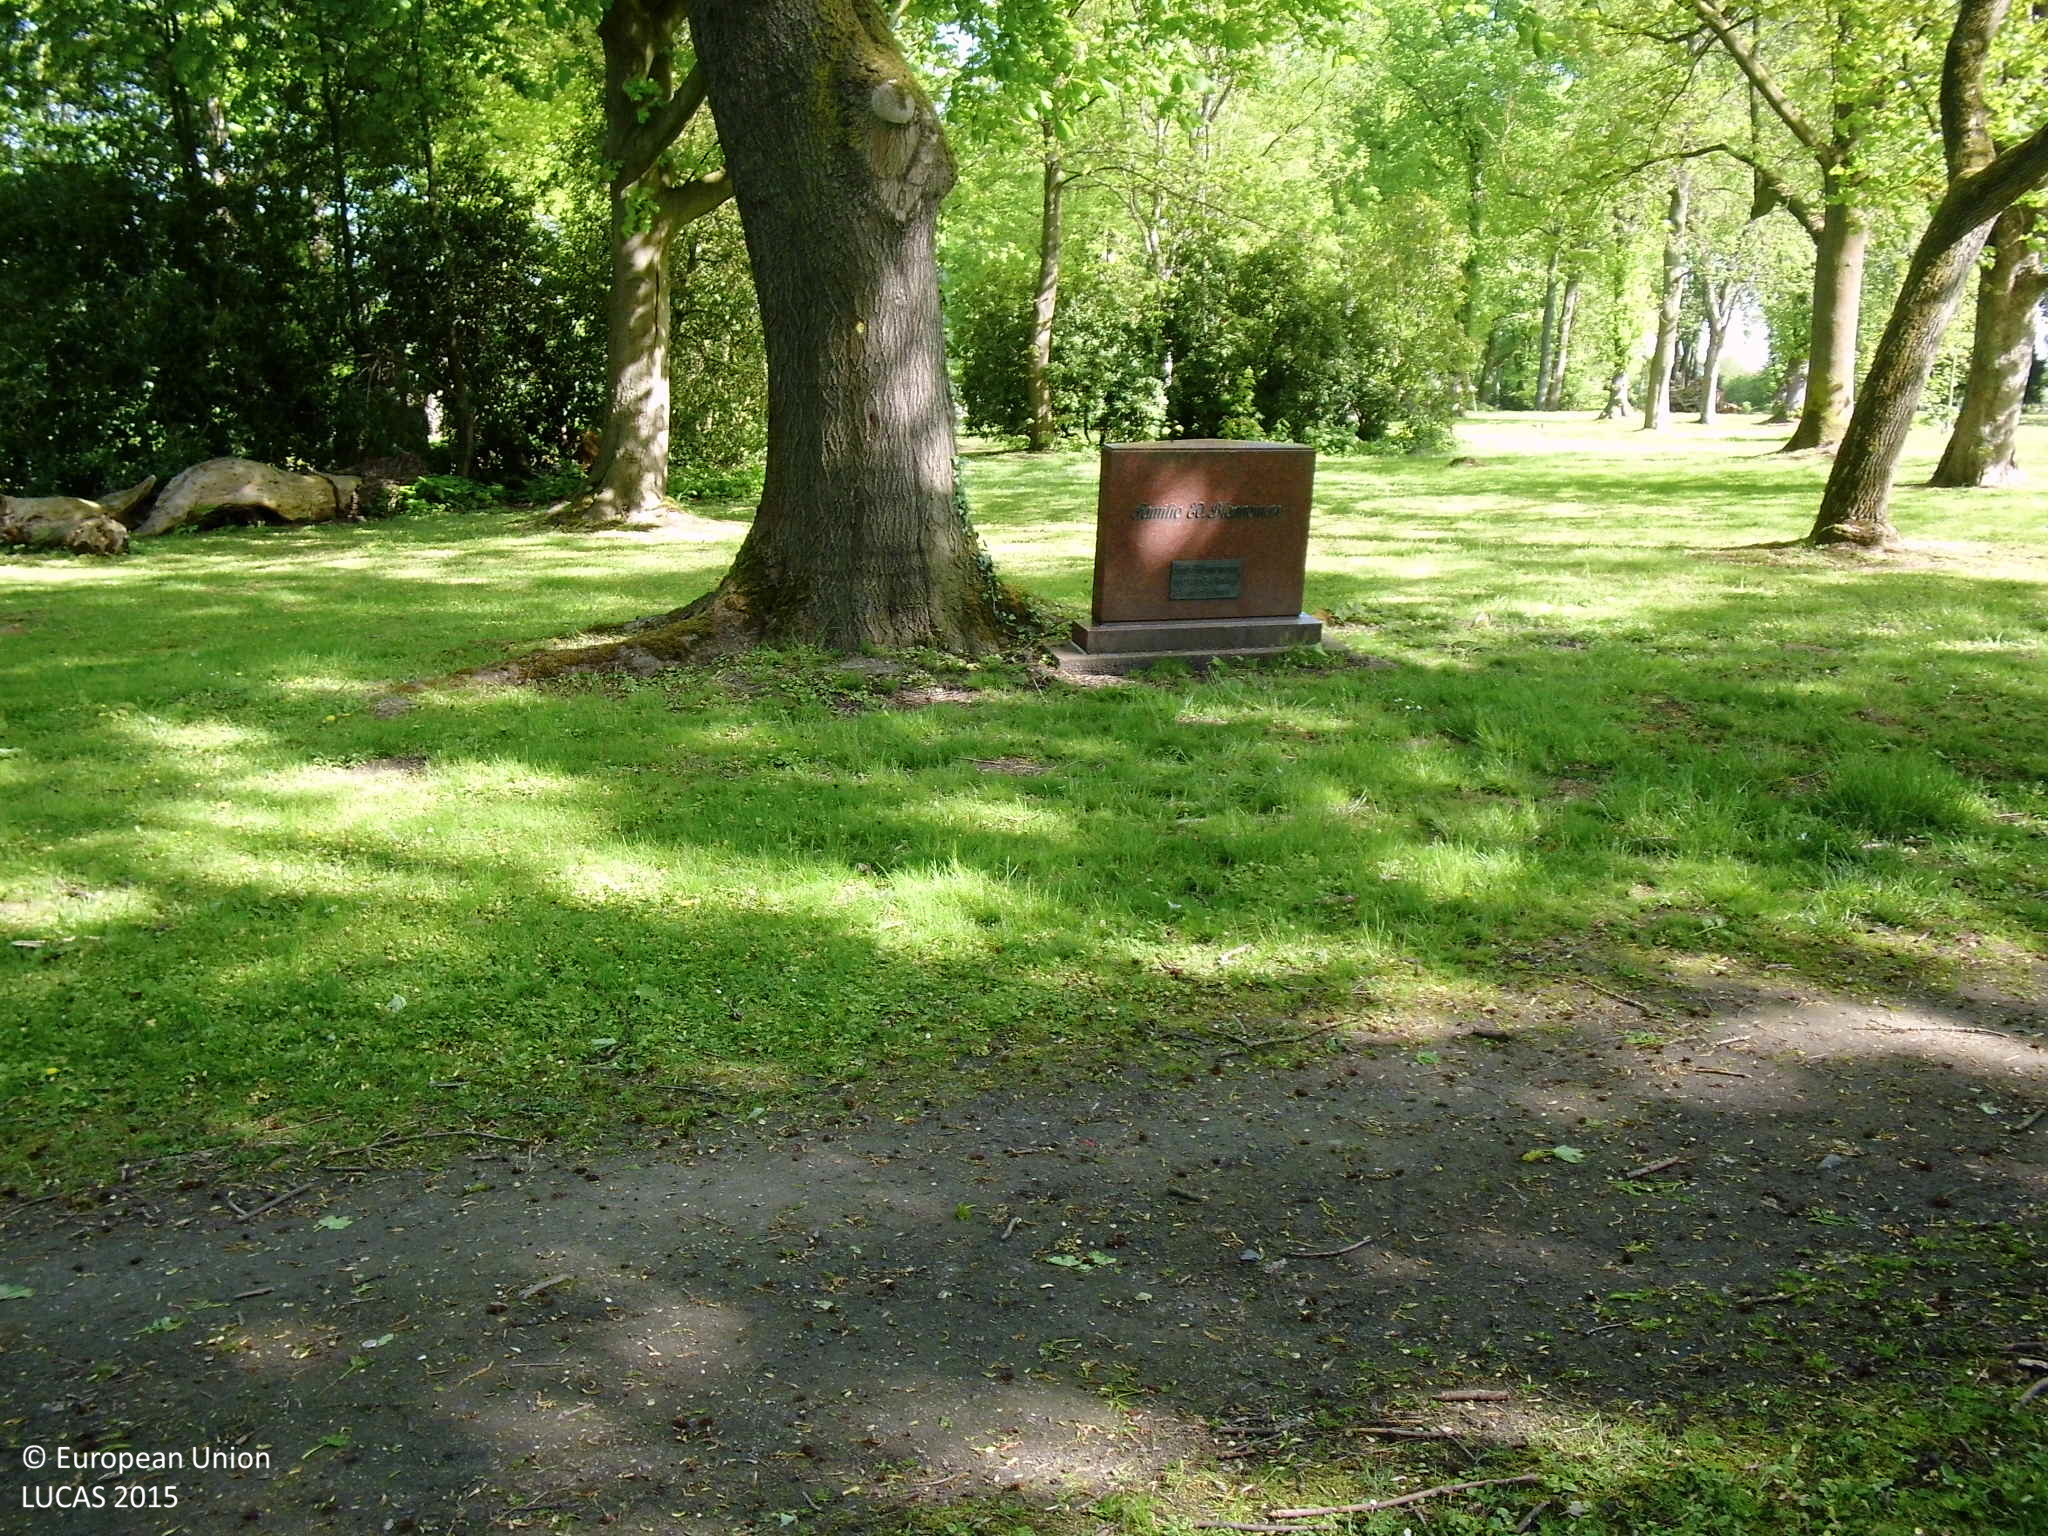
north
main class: Woodland
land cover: Broadleaved woodland
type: mesophytic deciduous forest
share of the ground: > 75 %
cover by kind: broadleaved forest trees 80 %, herbaceous plants 10 %, shrubs 5 %, unconsolidated bare surface 5 %
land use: Community services
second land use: Amenities, museums, leisure
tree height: > 5 m
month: May
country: DE
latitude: 51.5042
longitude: 7.4214
